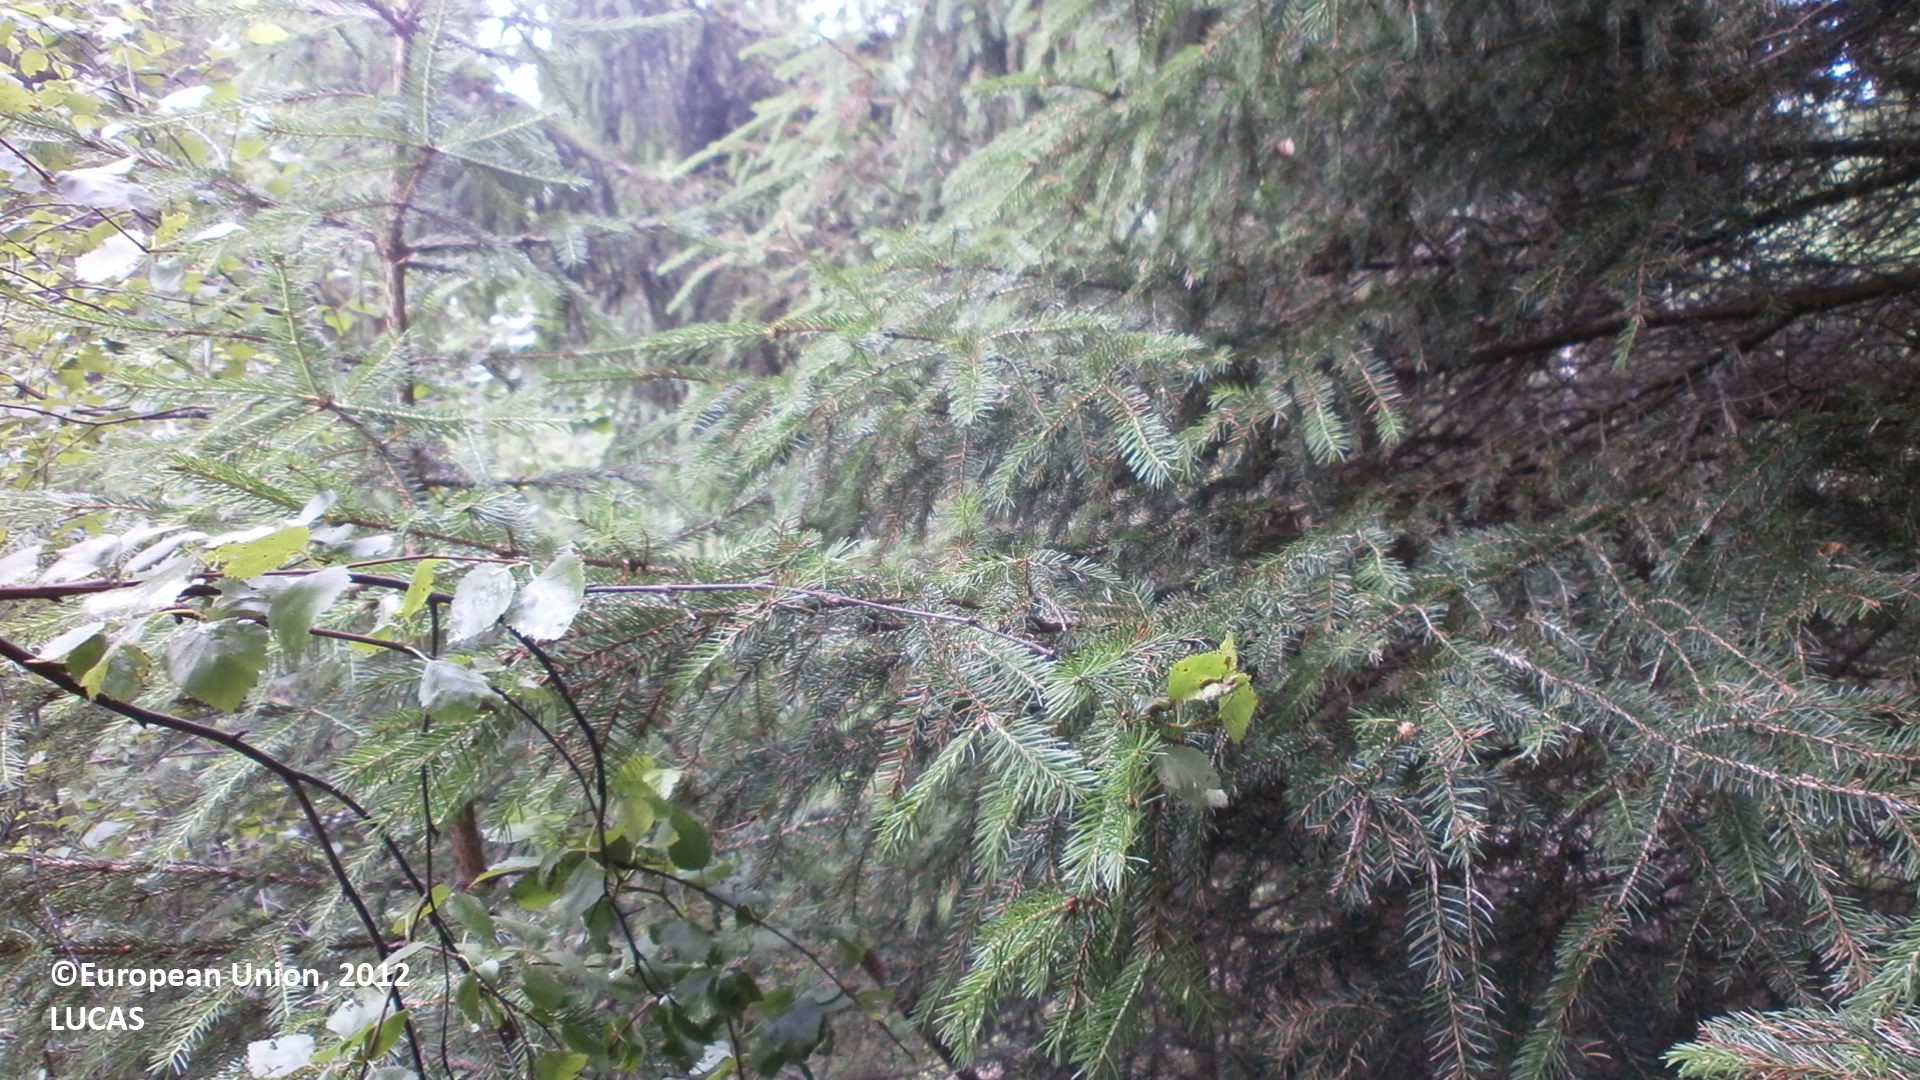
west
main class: Woodland
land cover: Spruce dominated coniferous woodland
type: boreal forest
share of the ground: > 75 %
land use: Forestry
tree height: > 5 m
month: July
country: FI
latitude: 64.2342
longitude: 24.4001
